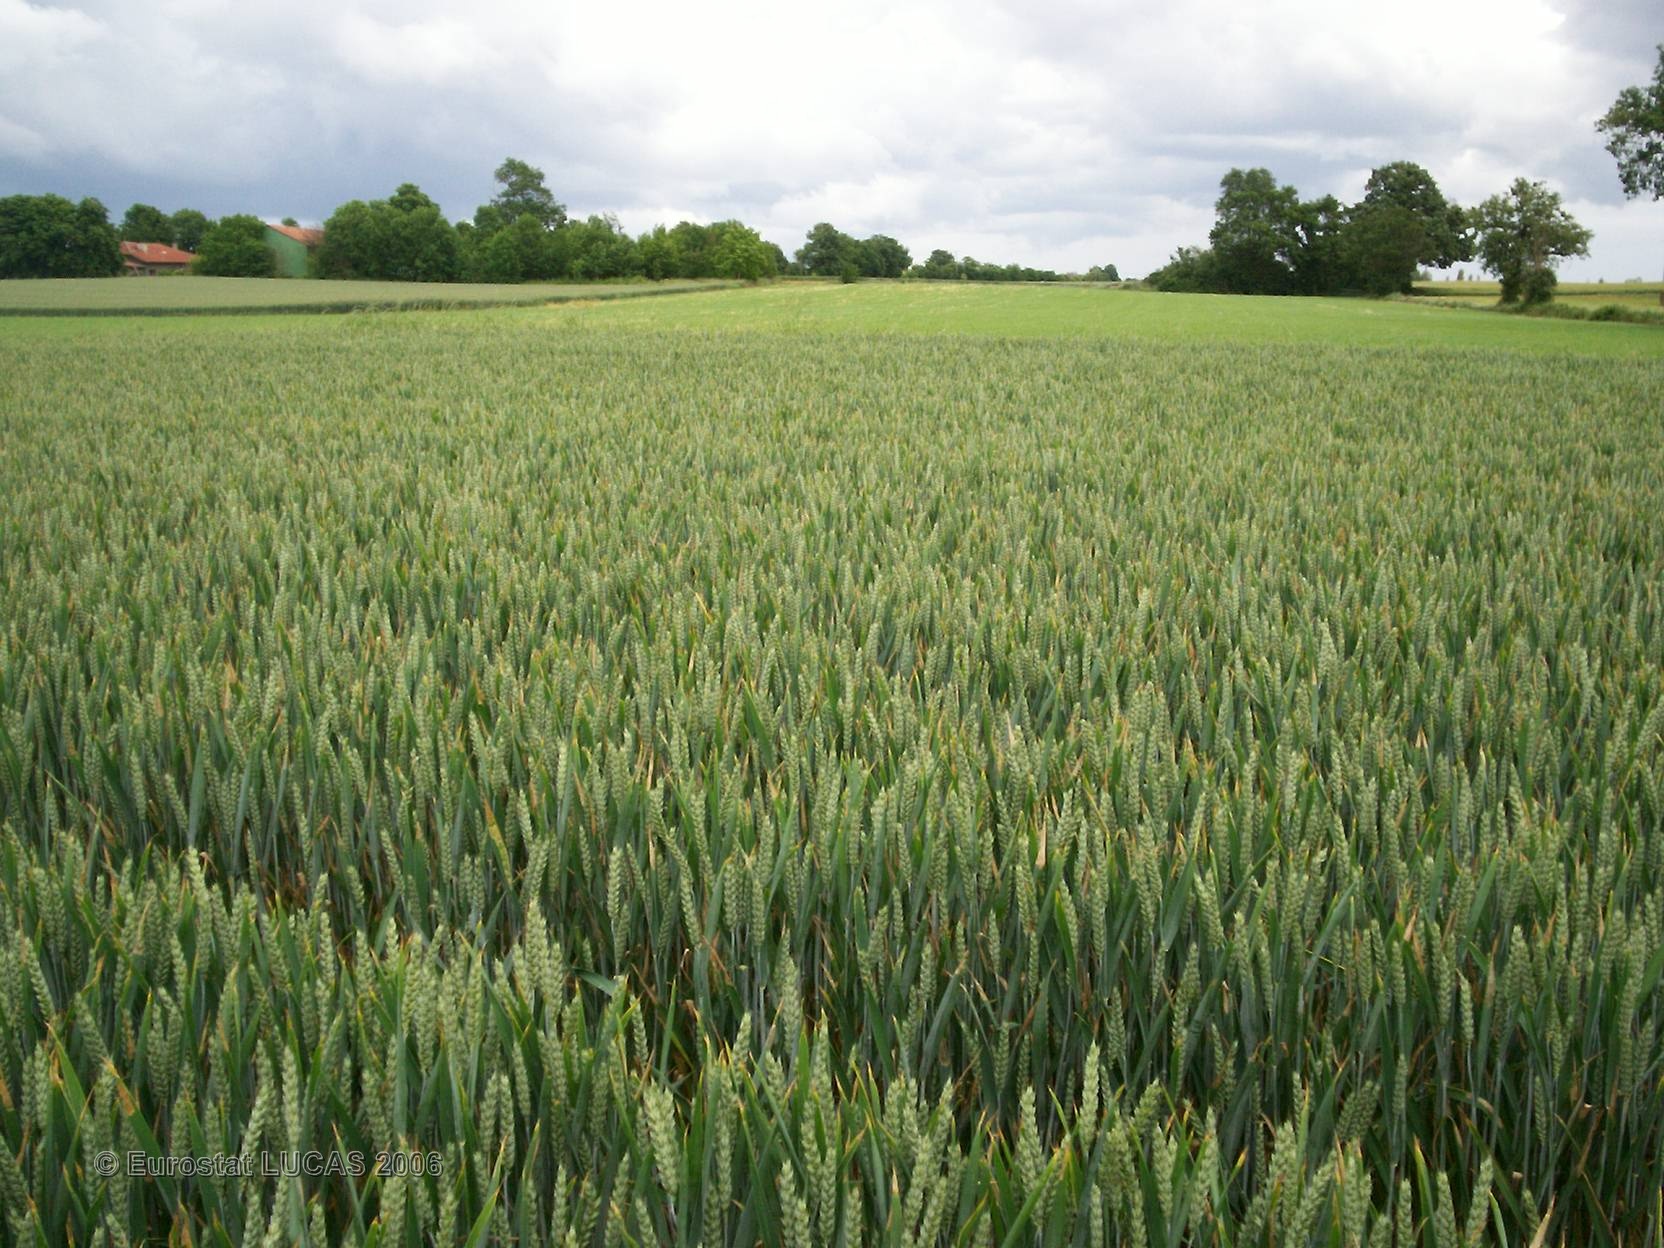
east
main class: Cropland
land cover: Common wheat
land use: Agriculture (excluding fallow land and kitchen gardens)
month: May
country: FR
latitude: 43.6113
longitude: 0.9676
